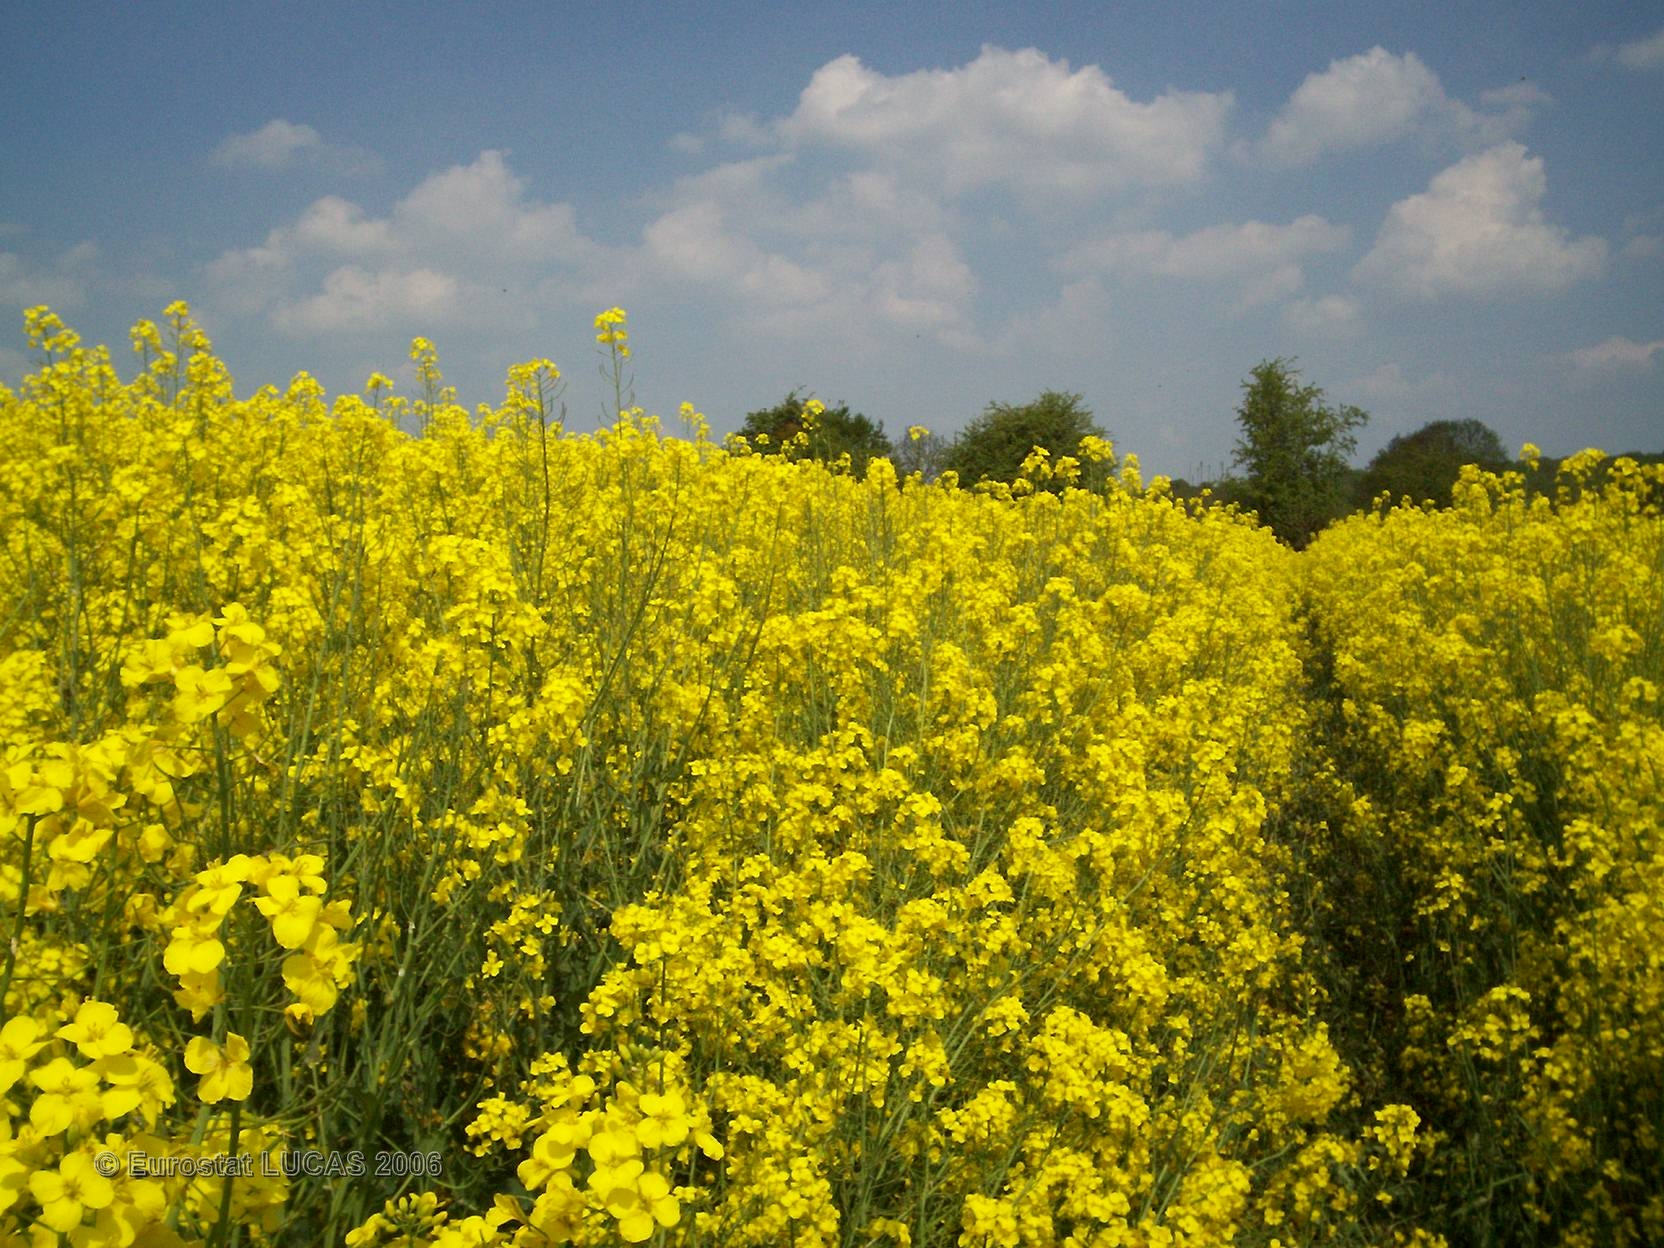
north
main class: Cropland
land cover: Rape and turnip rape
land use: Agriculture (excluding fallow land and kitchen gardens)
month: May
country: FR
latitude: 49.2287
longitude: 0.5402
